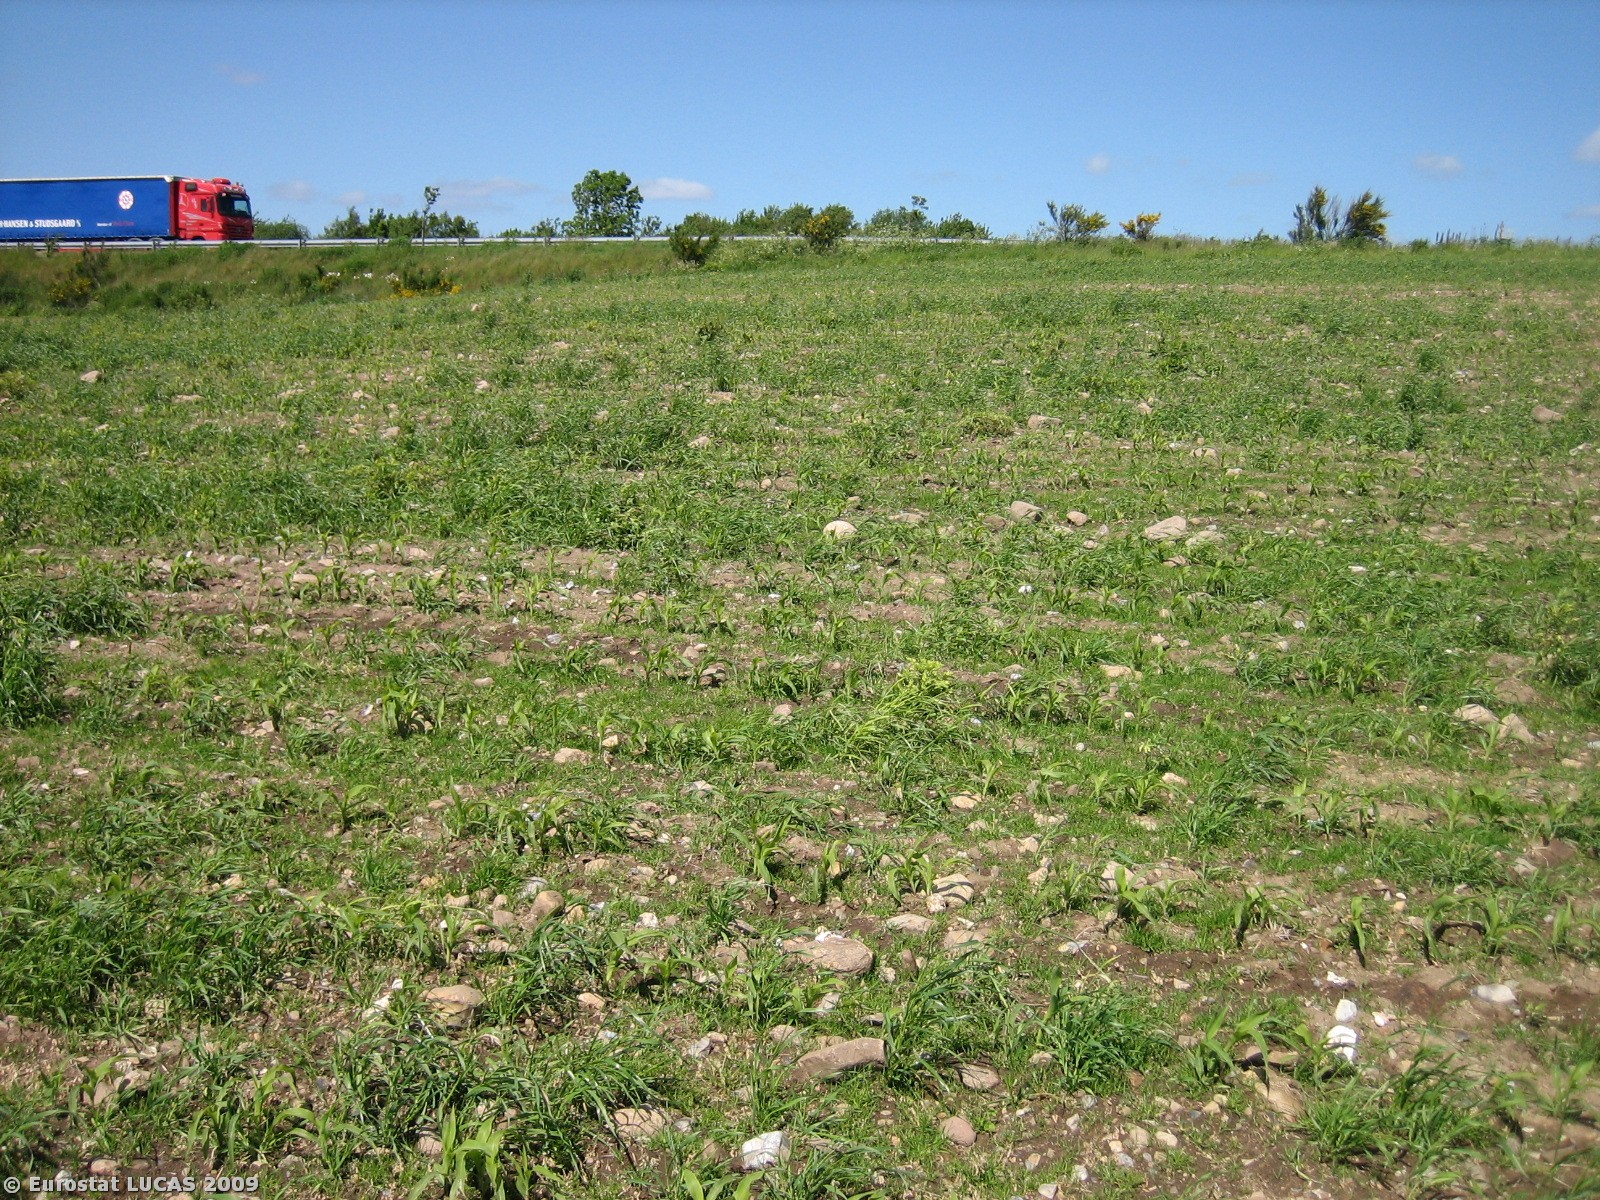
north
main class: Cropland
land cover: Maize
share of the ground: < 10 %
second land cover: Spontaneously vegetated surfaces
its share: 25 - 50 %
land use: Agriculture (excluding fallow land and kitchen gardens)
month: June
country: DK
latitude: 55.9177
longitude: 9.6963
